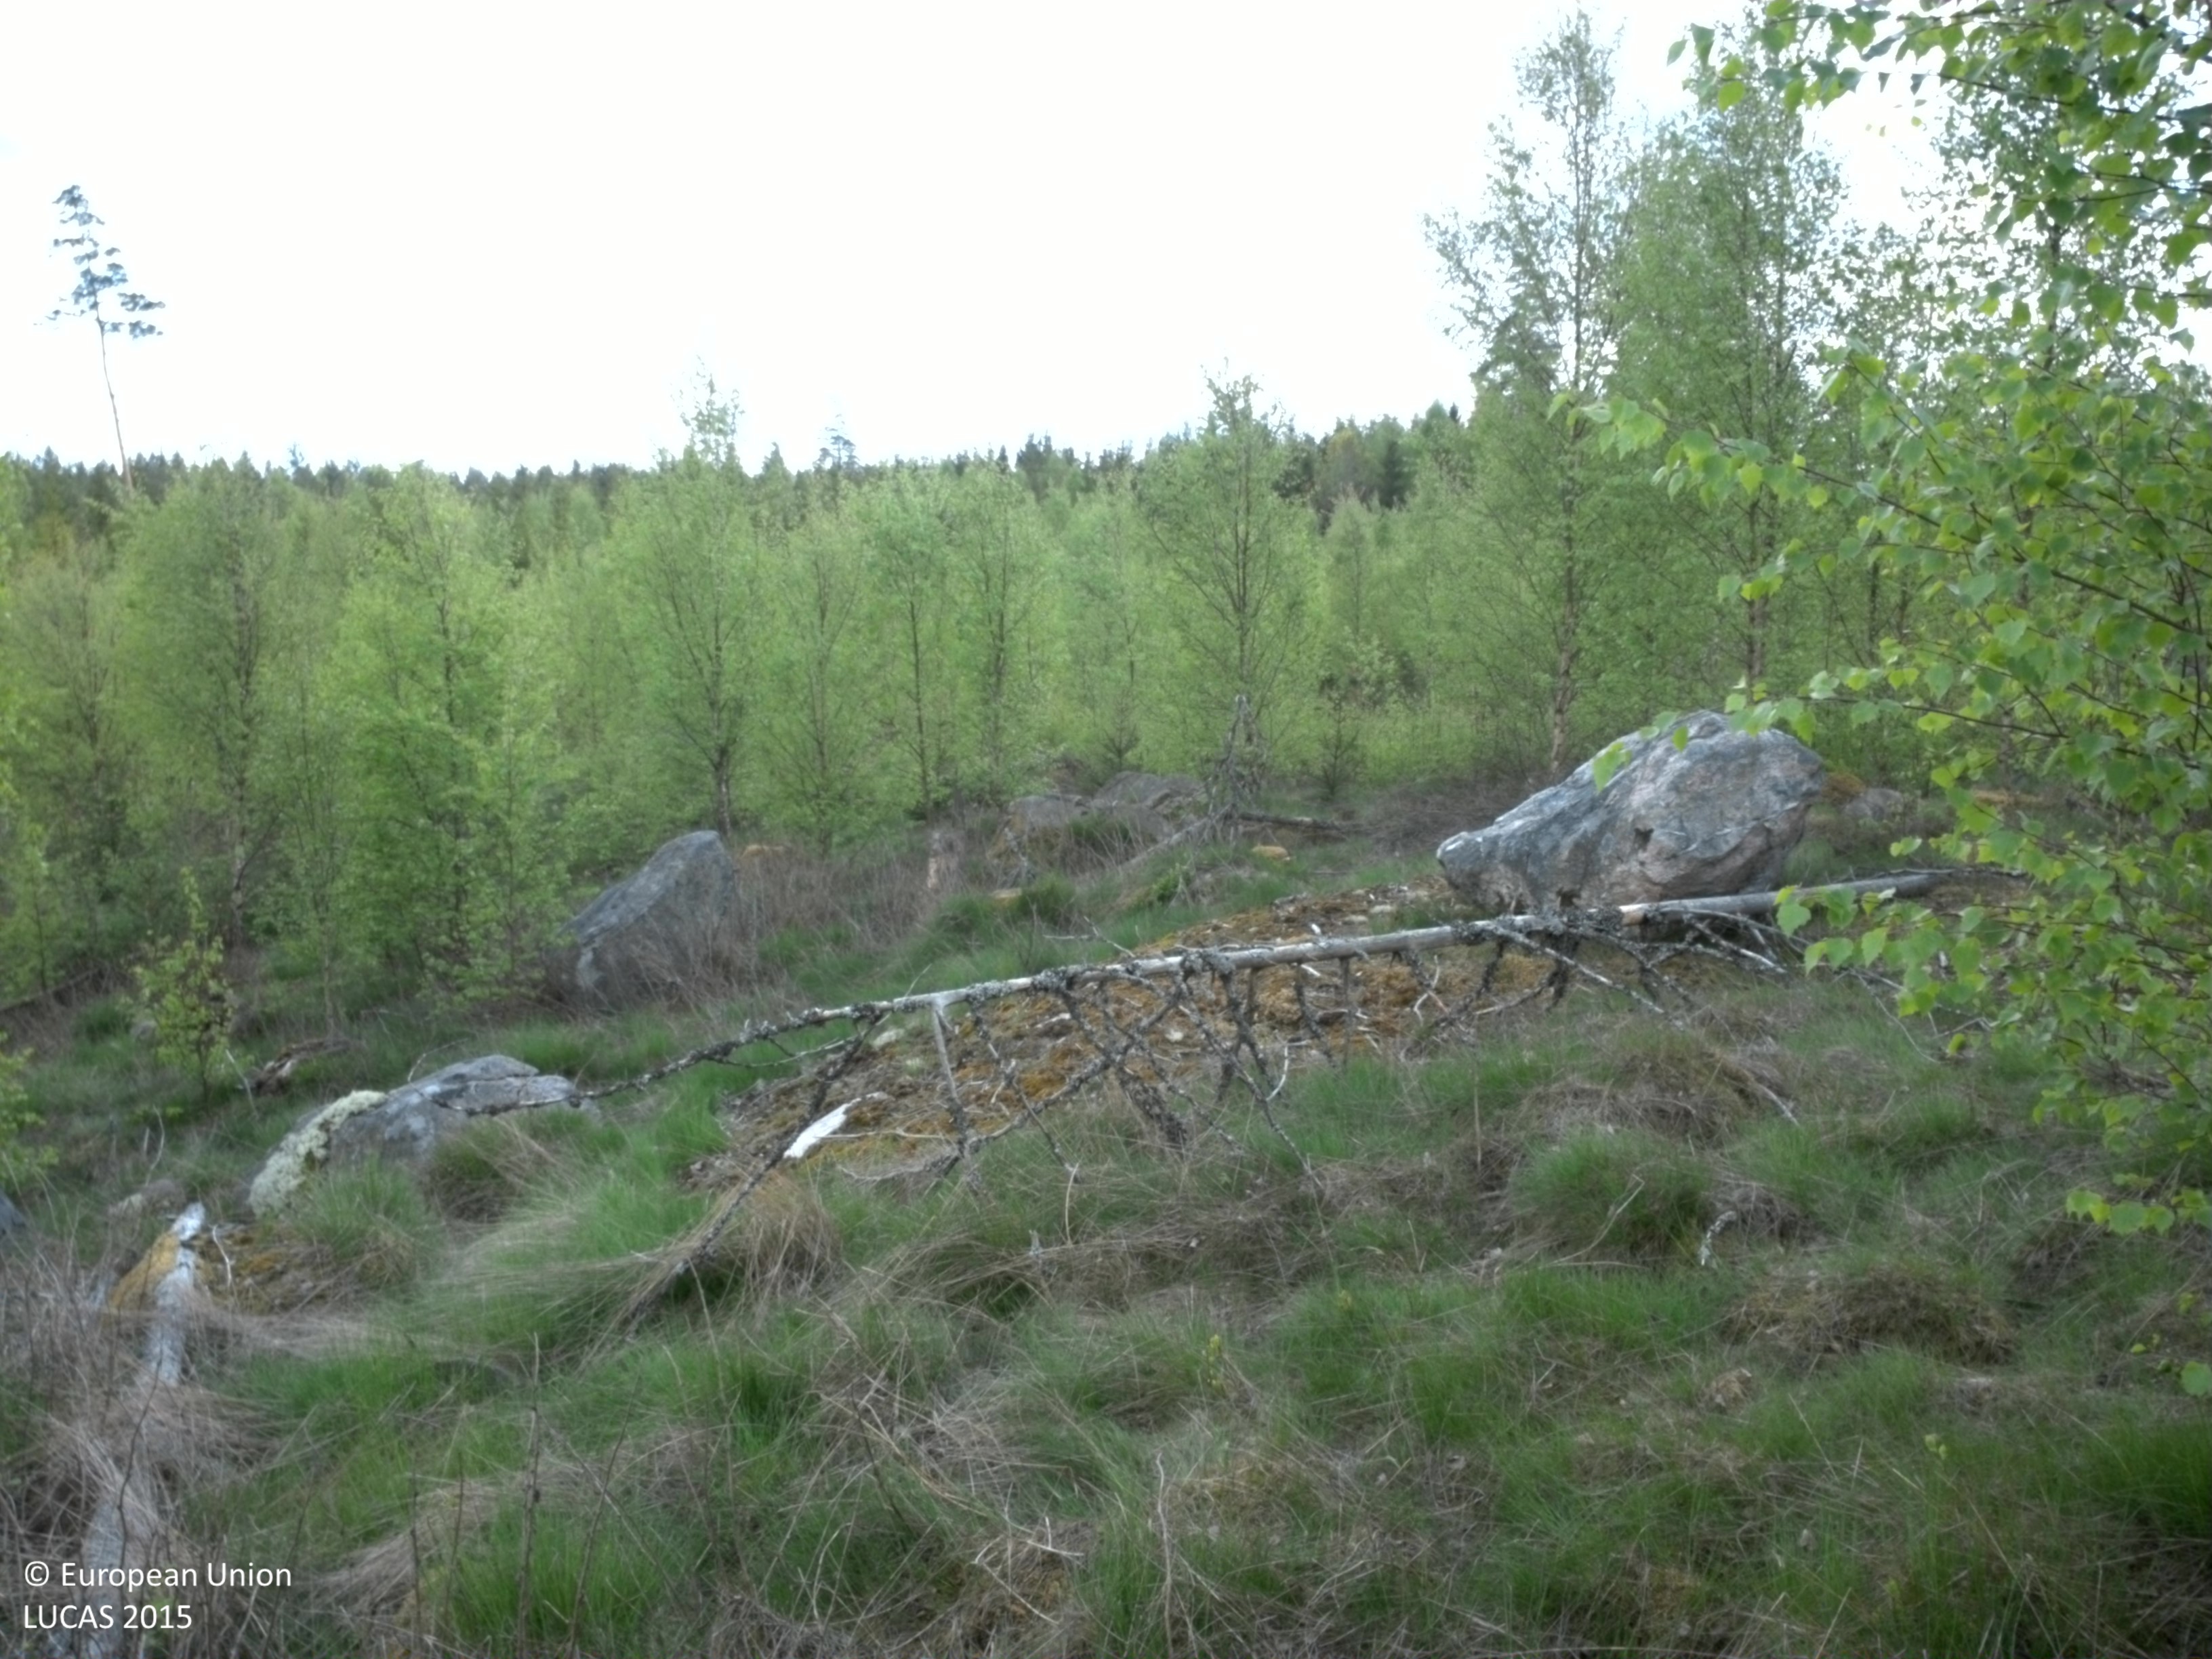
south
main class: Woodland
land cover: Broadleaved woodland
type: boreal forest
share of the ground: 50 - 75 %
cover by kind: broadleaved forest trees 60 %, herbaceous plants 30 %, coniferous forest trees 10 %
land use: Forestry
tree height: > 5 m
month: May
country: SE
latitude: 56.7036
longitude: 14.4887
